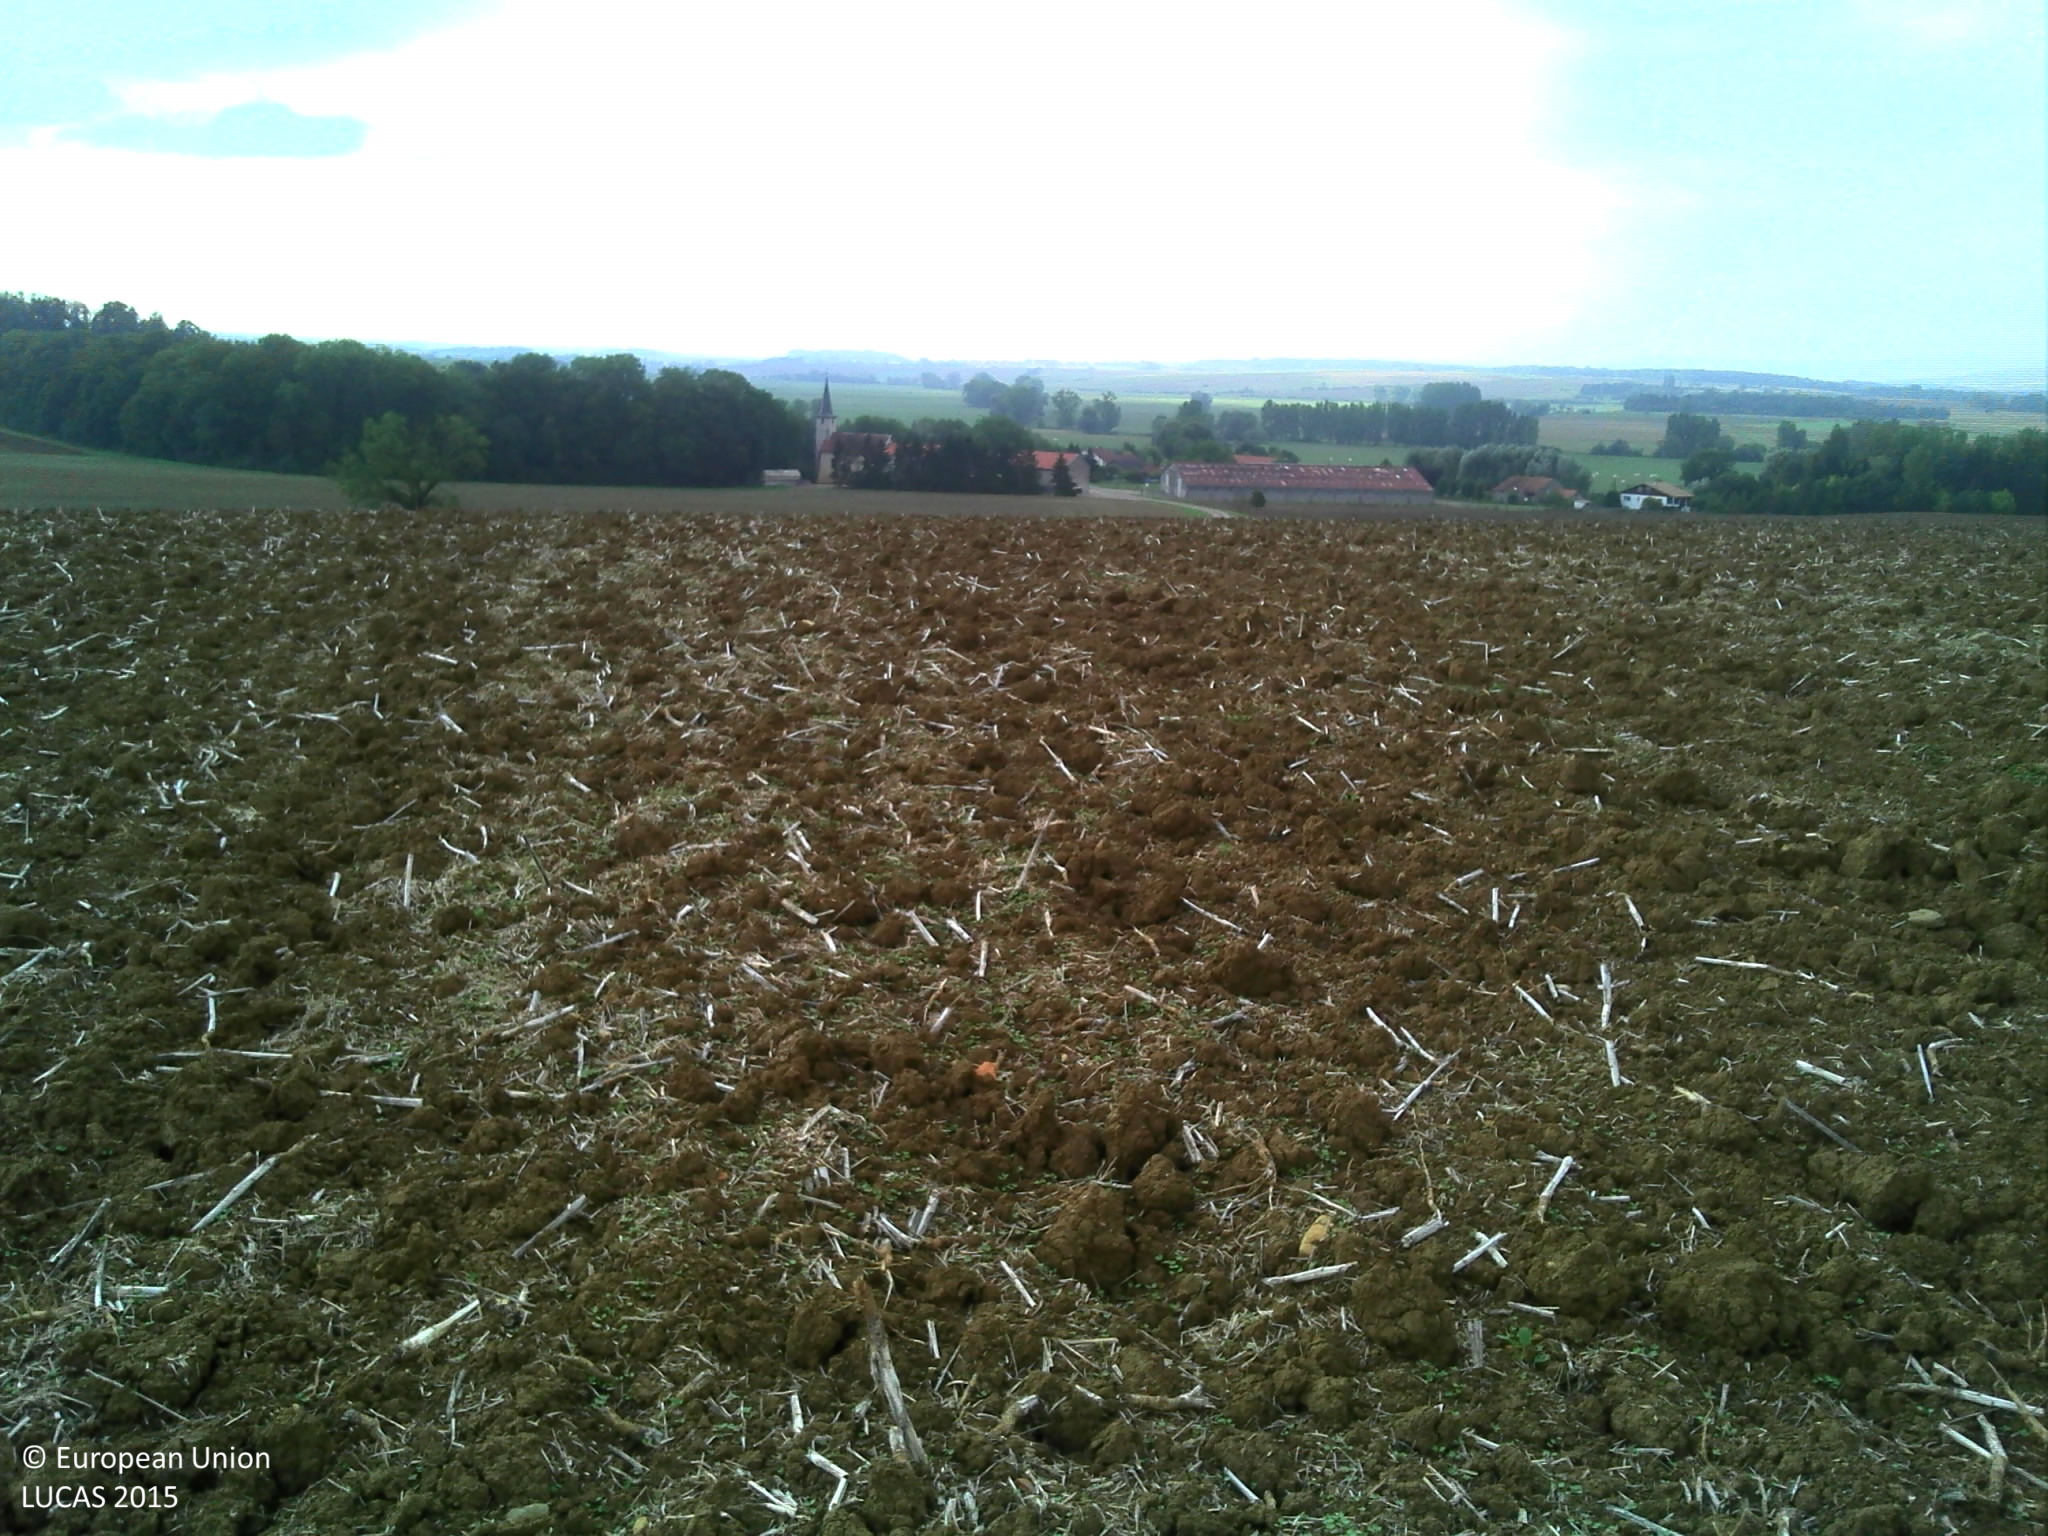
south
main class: Cropland
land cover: Rape and turnip rape
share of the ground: < 10 %
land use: Agriculture (excluding fallow land and kitchen gardens)
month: September
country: FR
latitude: 48.9171
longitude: 6.2745
